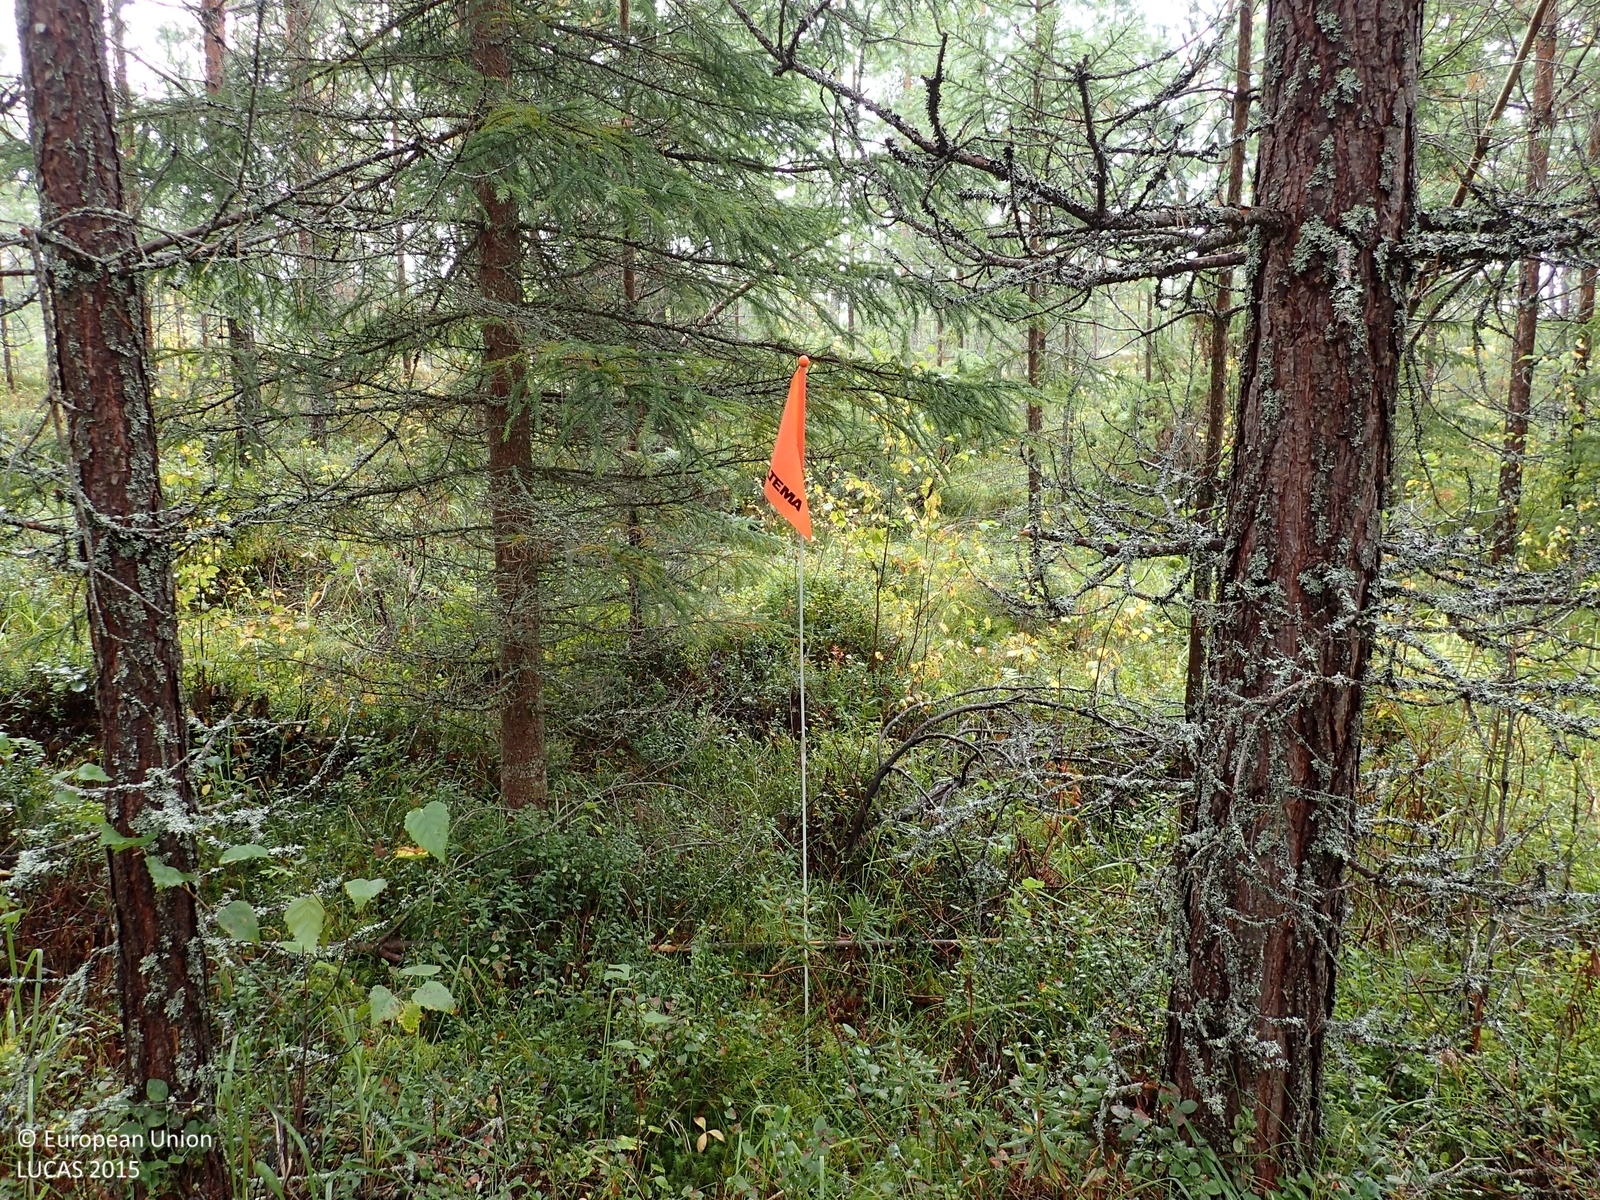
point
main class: Woodland
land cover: Pine dominated coniferous woodland
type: boreal forest
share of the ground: 50 - 75 %
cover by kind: coniferous forest trees 60 %, shrubs 20 %, broadleaved forest trees 10 %, herbaceous plants 5 %, lichens and mosses 5 %
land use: Forestry
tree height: > 5 m
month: September
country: FI
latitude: 63.2320
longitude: 25.7735
